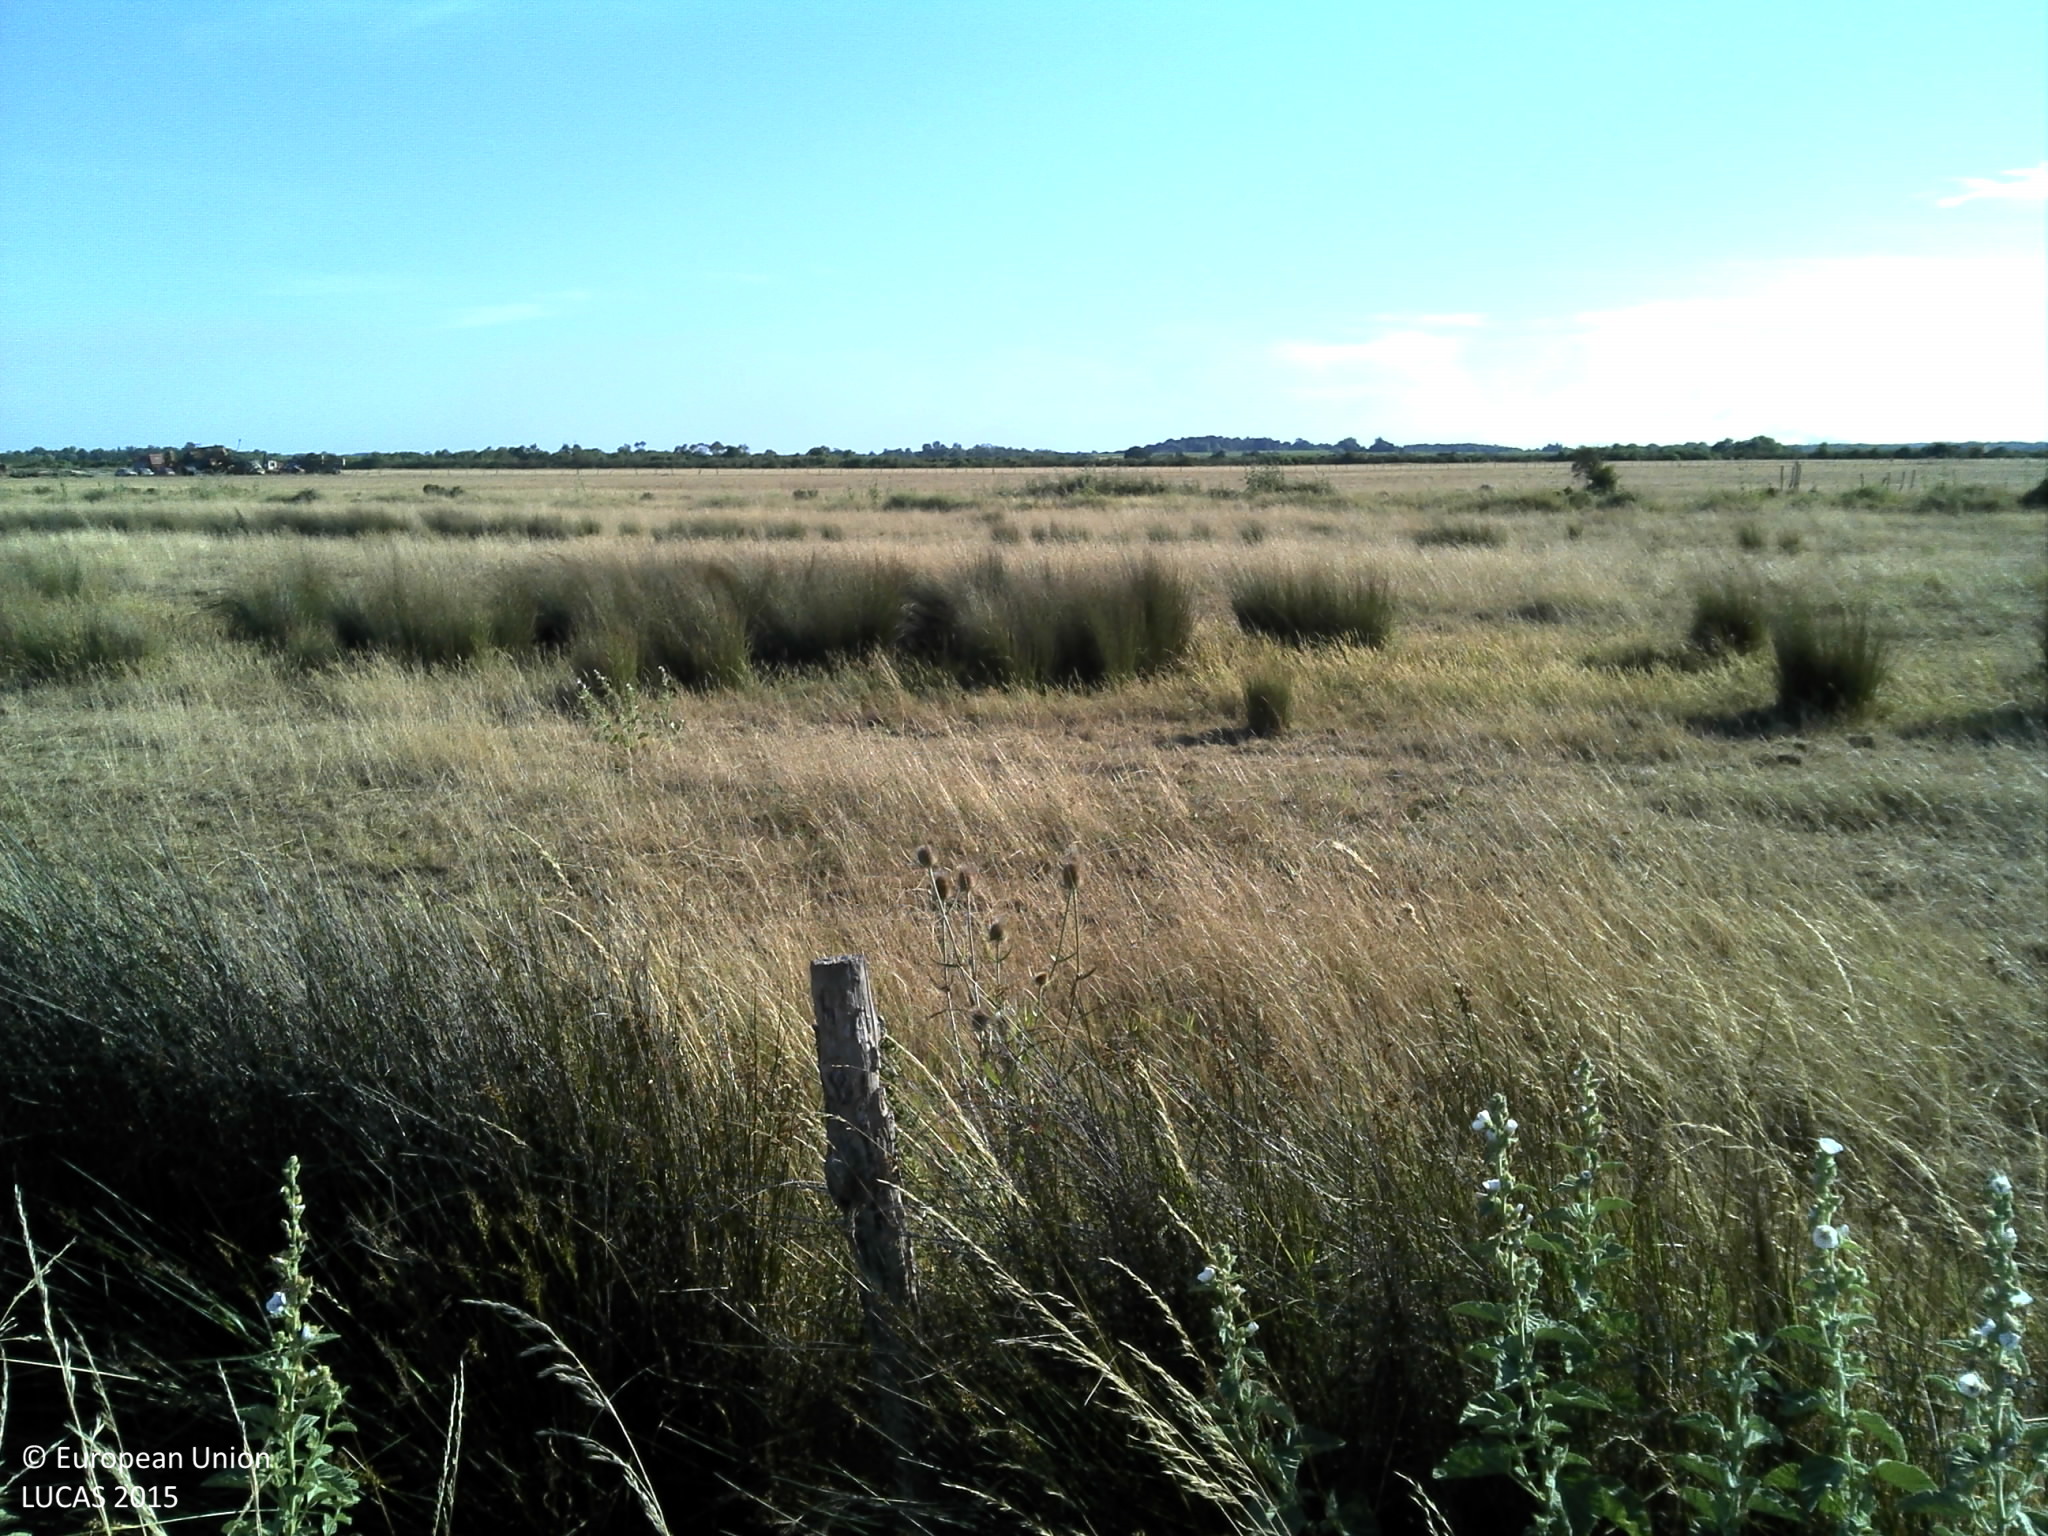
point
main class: Grassland
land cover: Grassland without tree/shrub cover
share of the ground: > 75 %
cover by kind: herbaceous plants 100 %
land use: Agriculture (excluding fallow land and kitchen gardens)
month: July
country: FR
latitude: 45.3120
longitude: -0.8017
